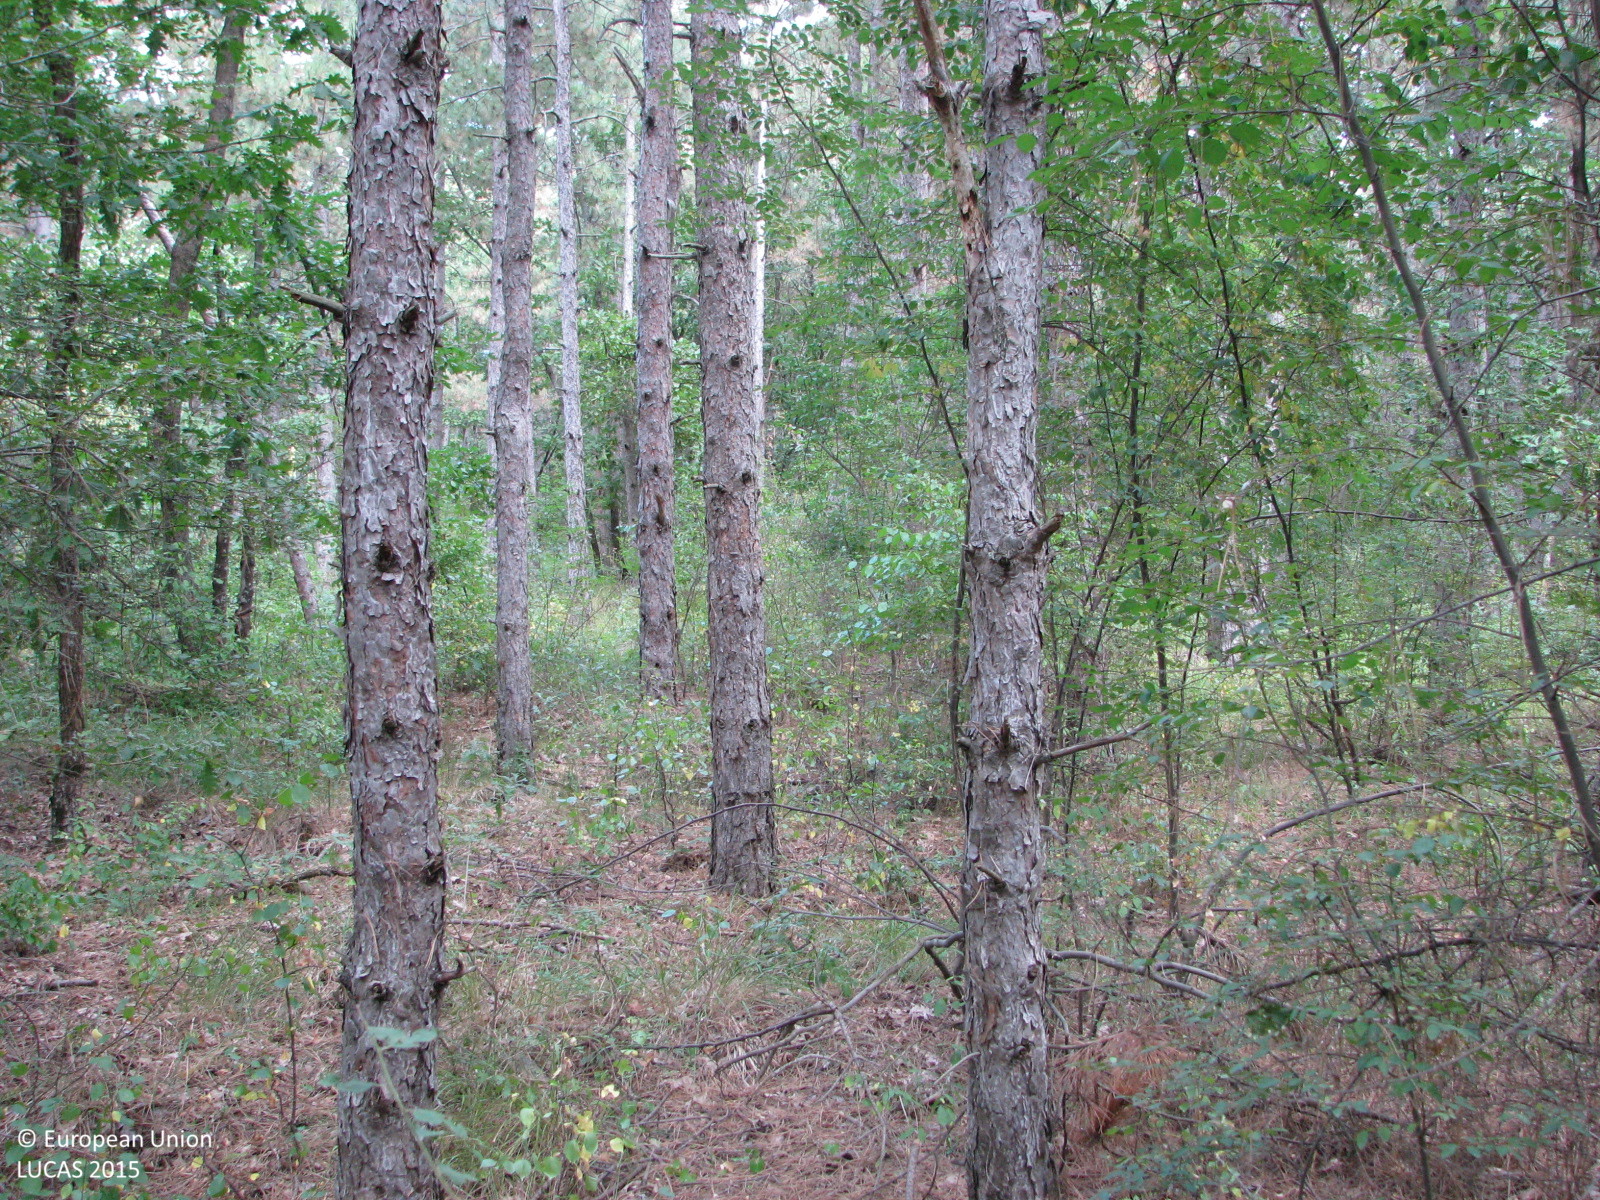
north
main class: Woodland
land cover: Pine dominated mixed woodland
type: hemiboreal forest and nemoral coniferous forest and mixed broadleaved-coniferous forest
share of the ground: > 75 %
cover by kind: coniferous forest trees 50 %, broadleaved forest trees 25 %, shrubs 15 %, herbaceous plants 10 %
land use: Forestry
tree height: > 5 m
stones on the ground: < 10 %
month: August
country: BG
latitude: 42.1051
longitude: 26.7942
